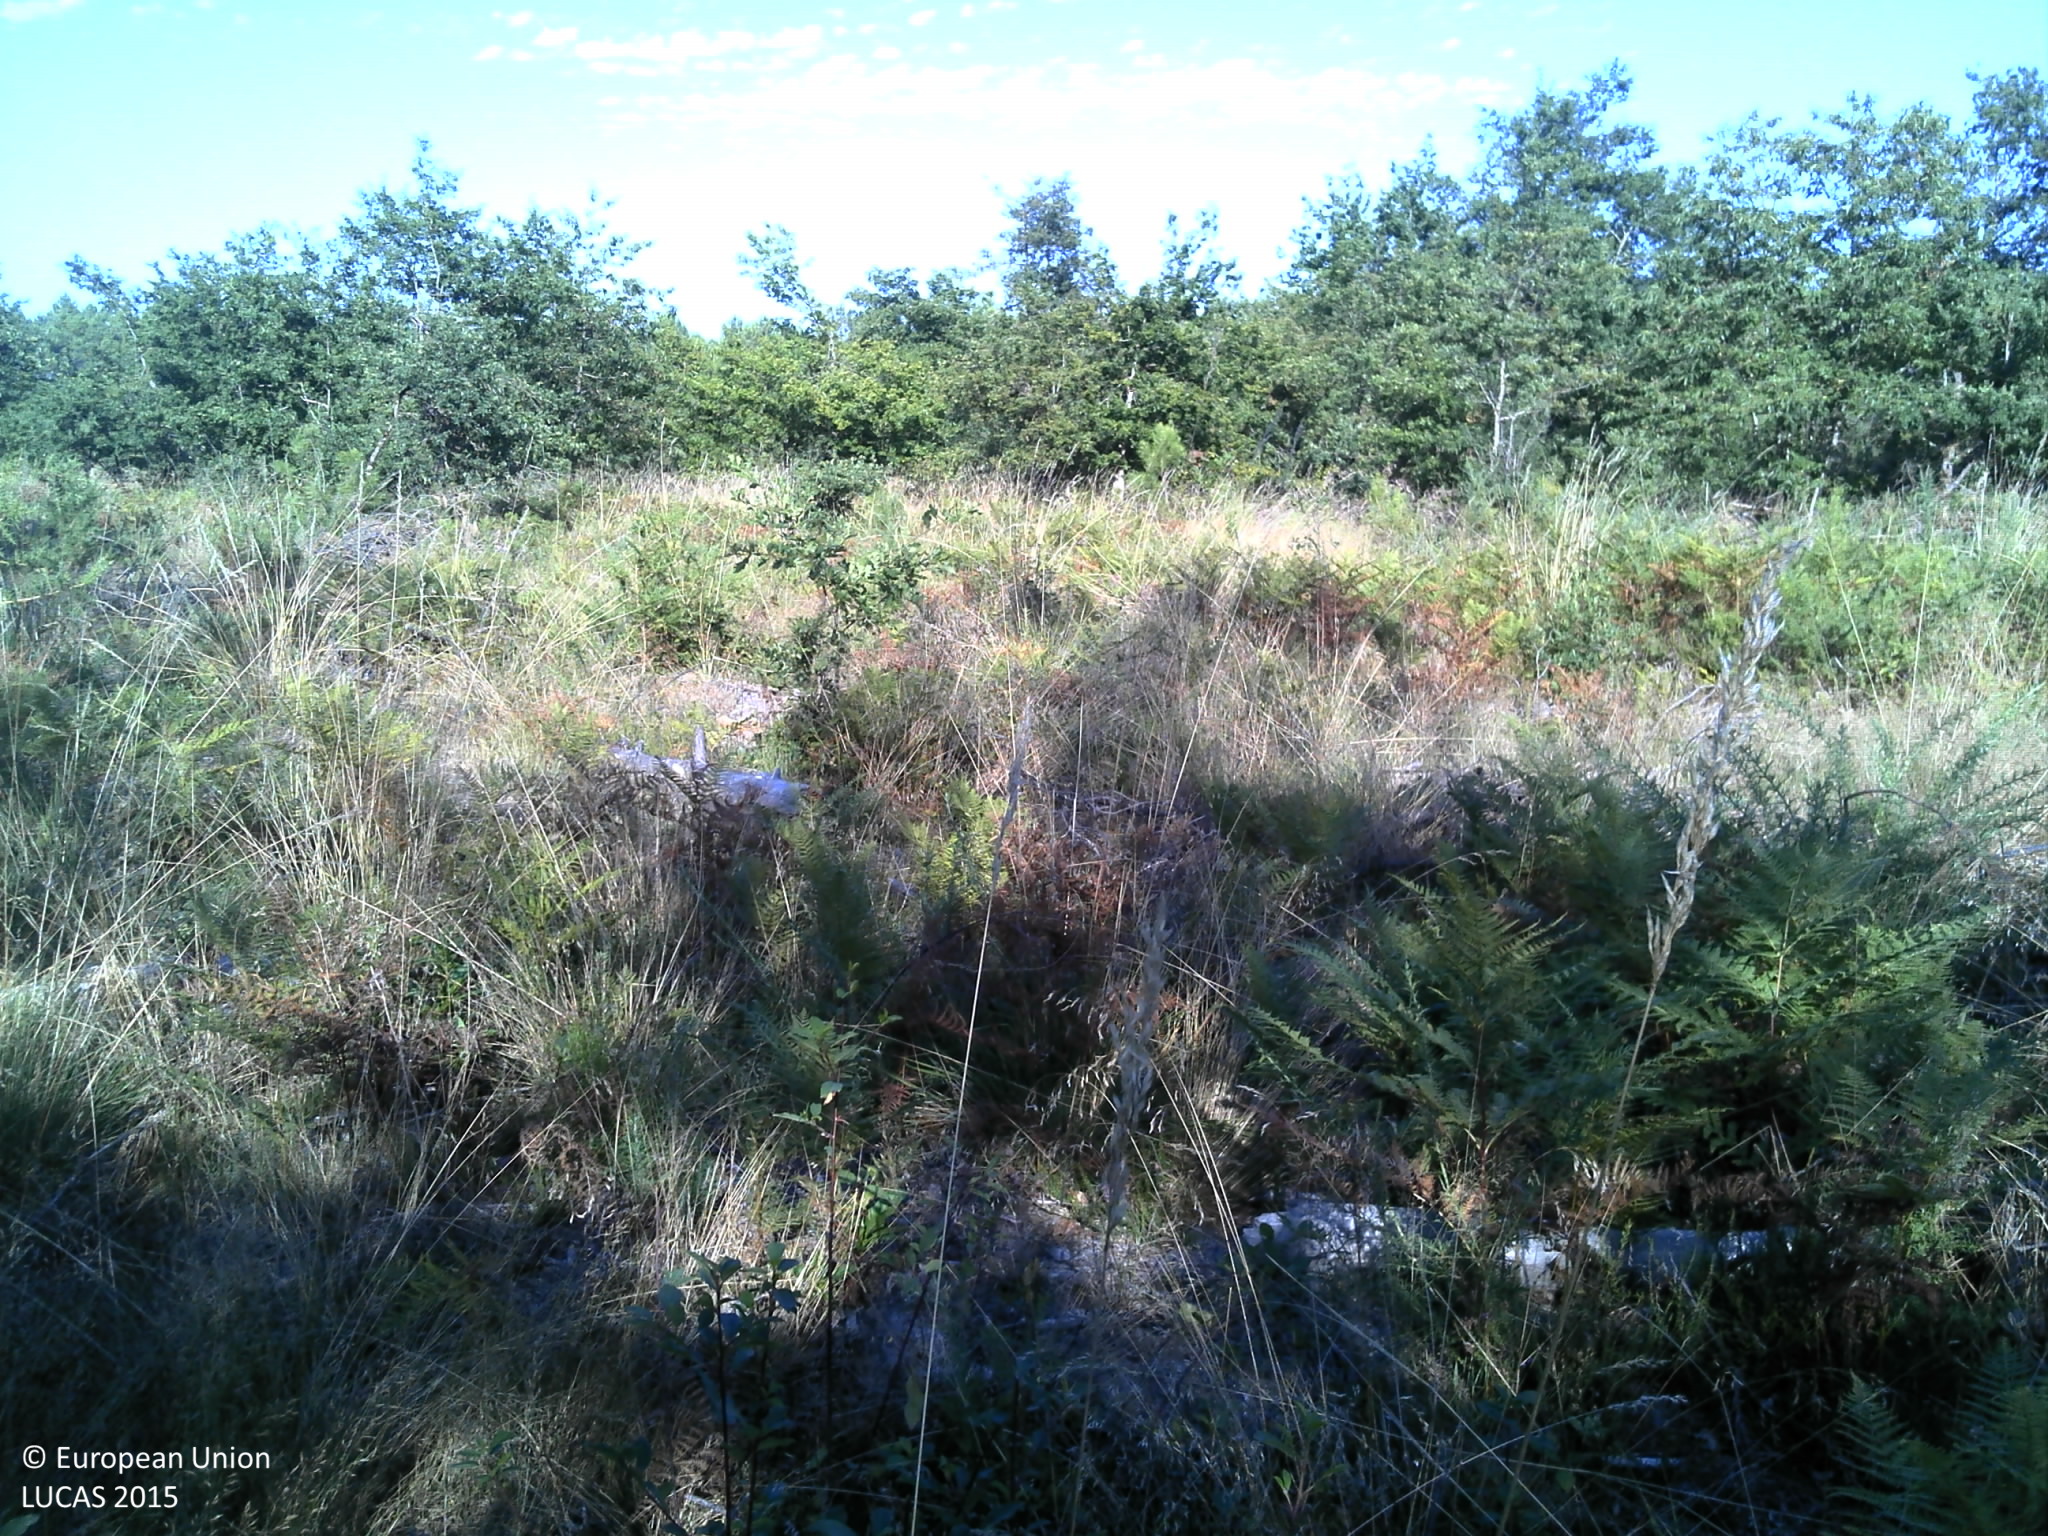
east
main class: Woodland
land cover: Pine dominated mixed woodland
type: coniferous forest of the mediterranean region
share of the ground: 50 - 75 %
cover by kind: broadleaved forest trees 50 %, coniferous forest trees 25 %, shrubs 15 %, herbaceous plants 5 %, lichens and mosses 5 %
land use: Forestry
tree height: < 5 m
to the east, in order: Pine dominated mixed woodland; Shrubland without tree cover; Pine dominated mixed woodland; Tracks; Pine dominated coniferous woodland
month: August
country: FR
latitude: 44.5051
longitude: -0.6964
